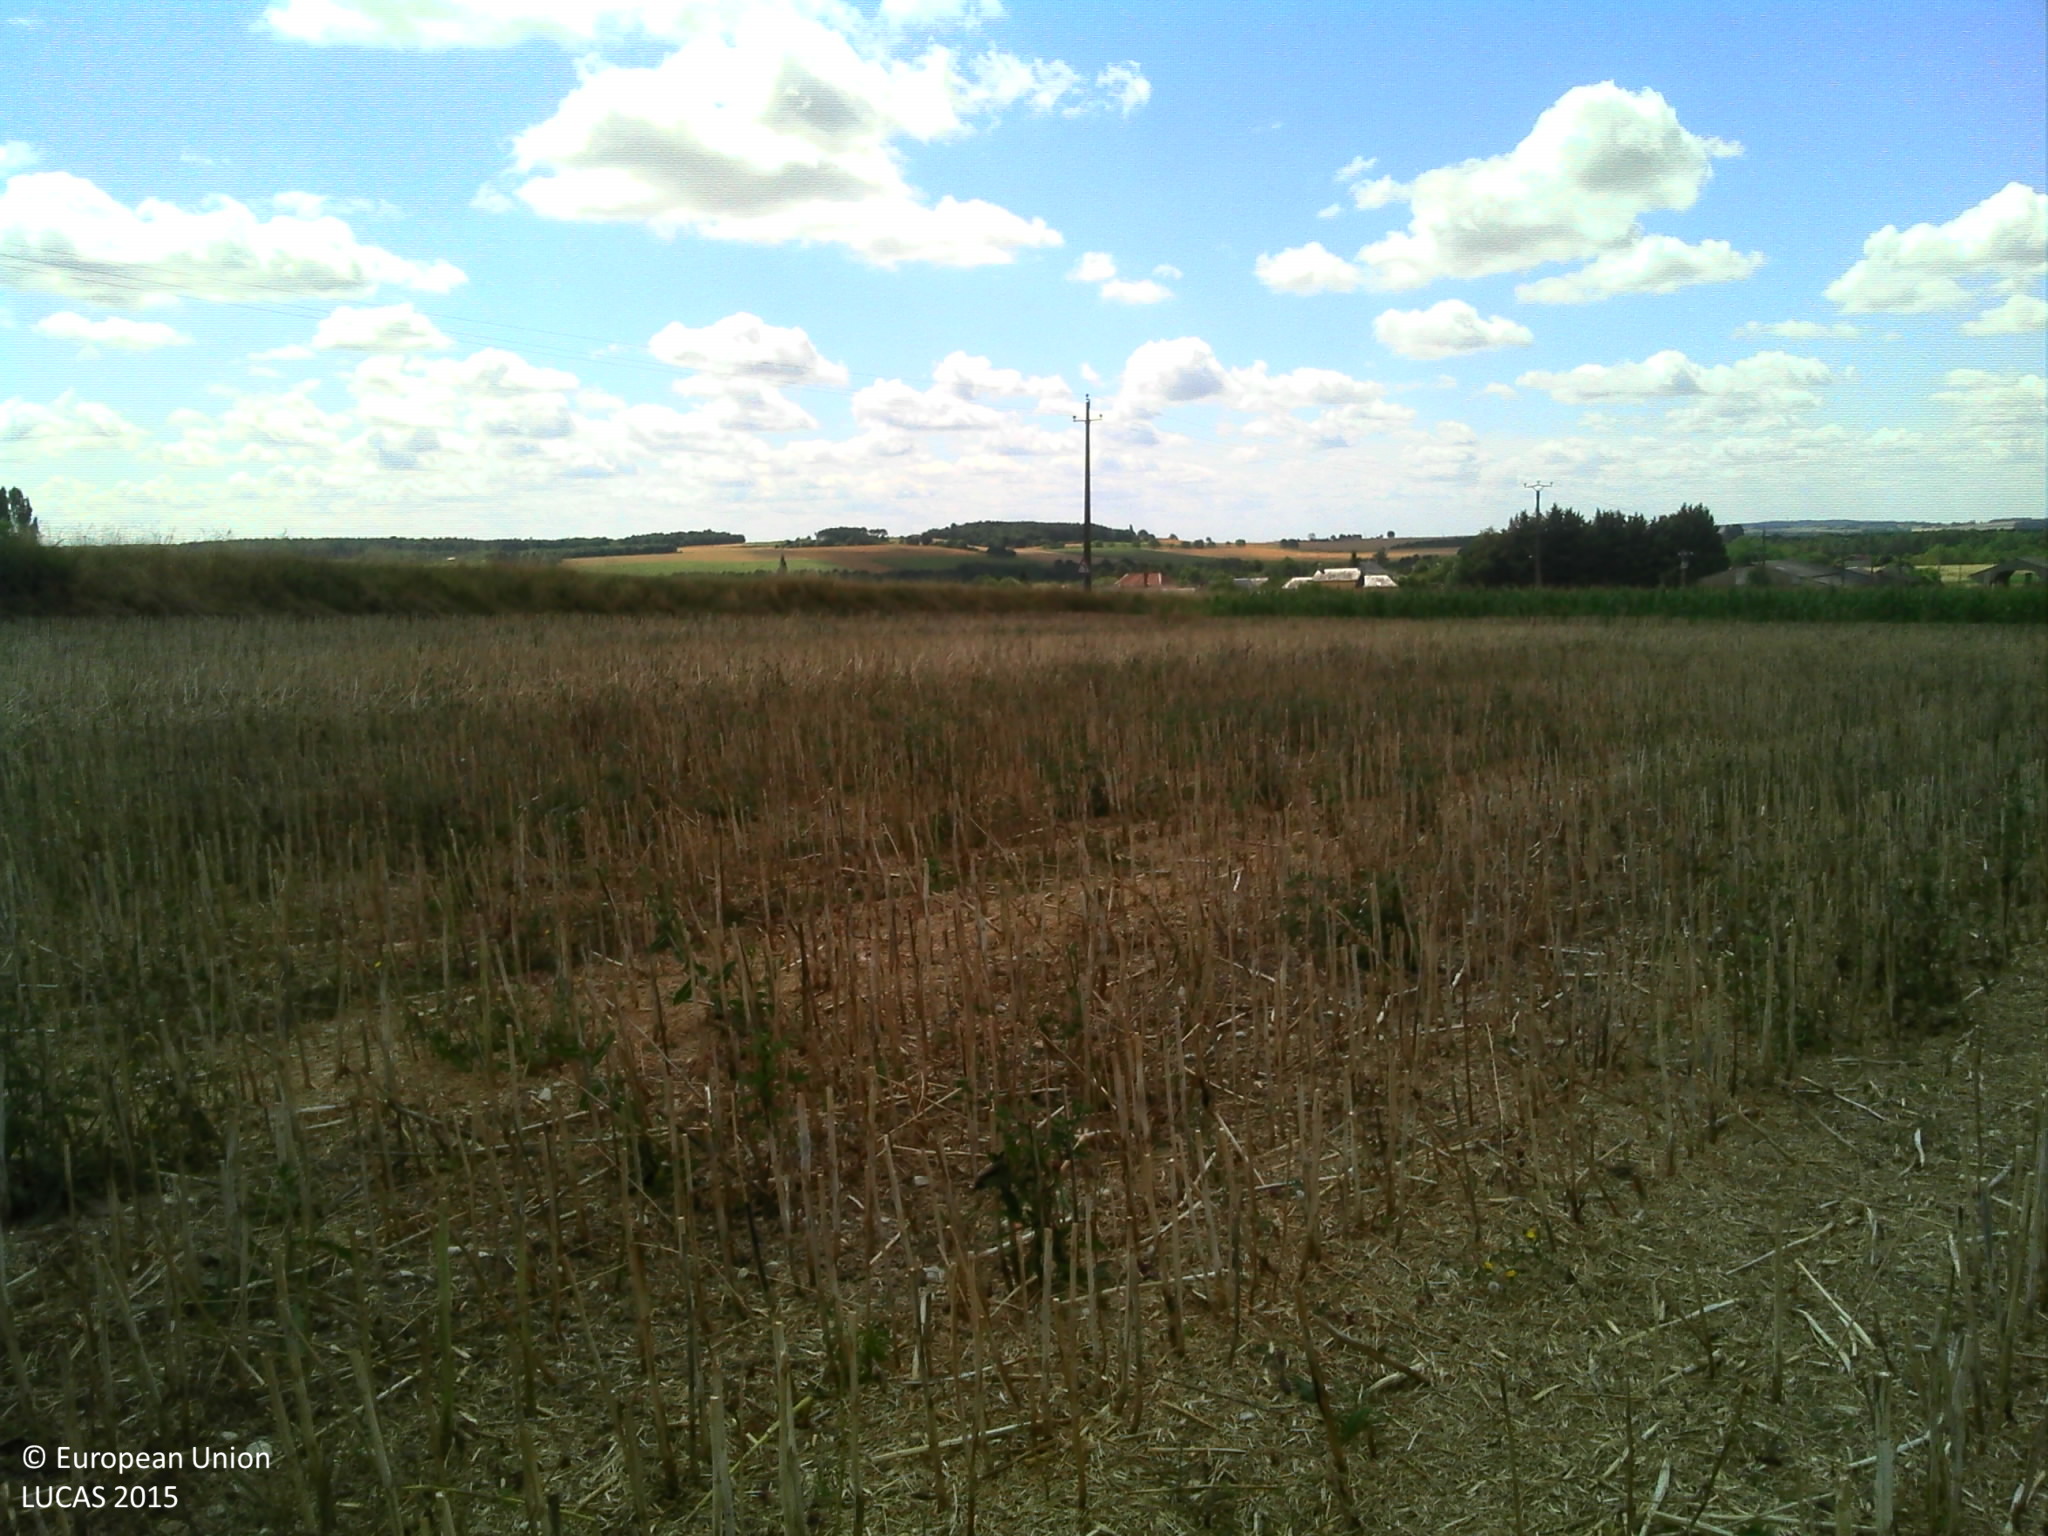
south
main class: Cropland
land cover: Rape and turnip rape
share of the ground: 10 - 25 %
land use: Agriculture (excluding fallow land and kitchen gardens)
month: July
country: FR
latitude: 47.0055
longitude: 0.3914
